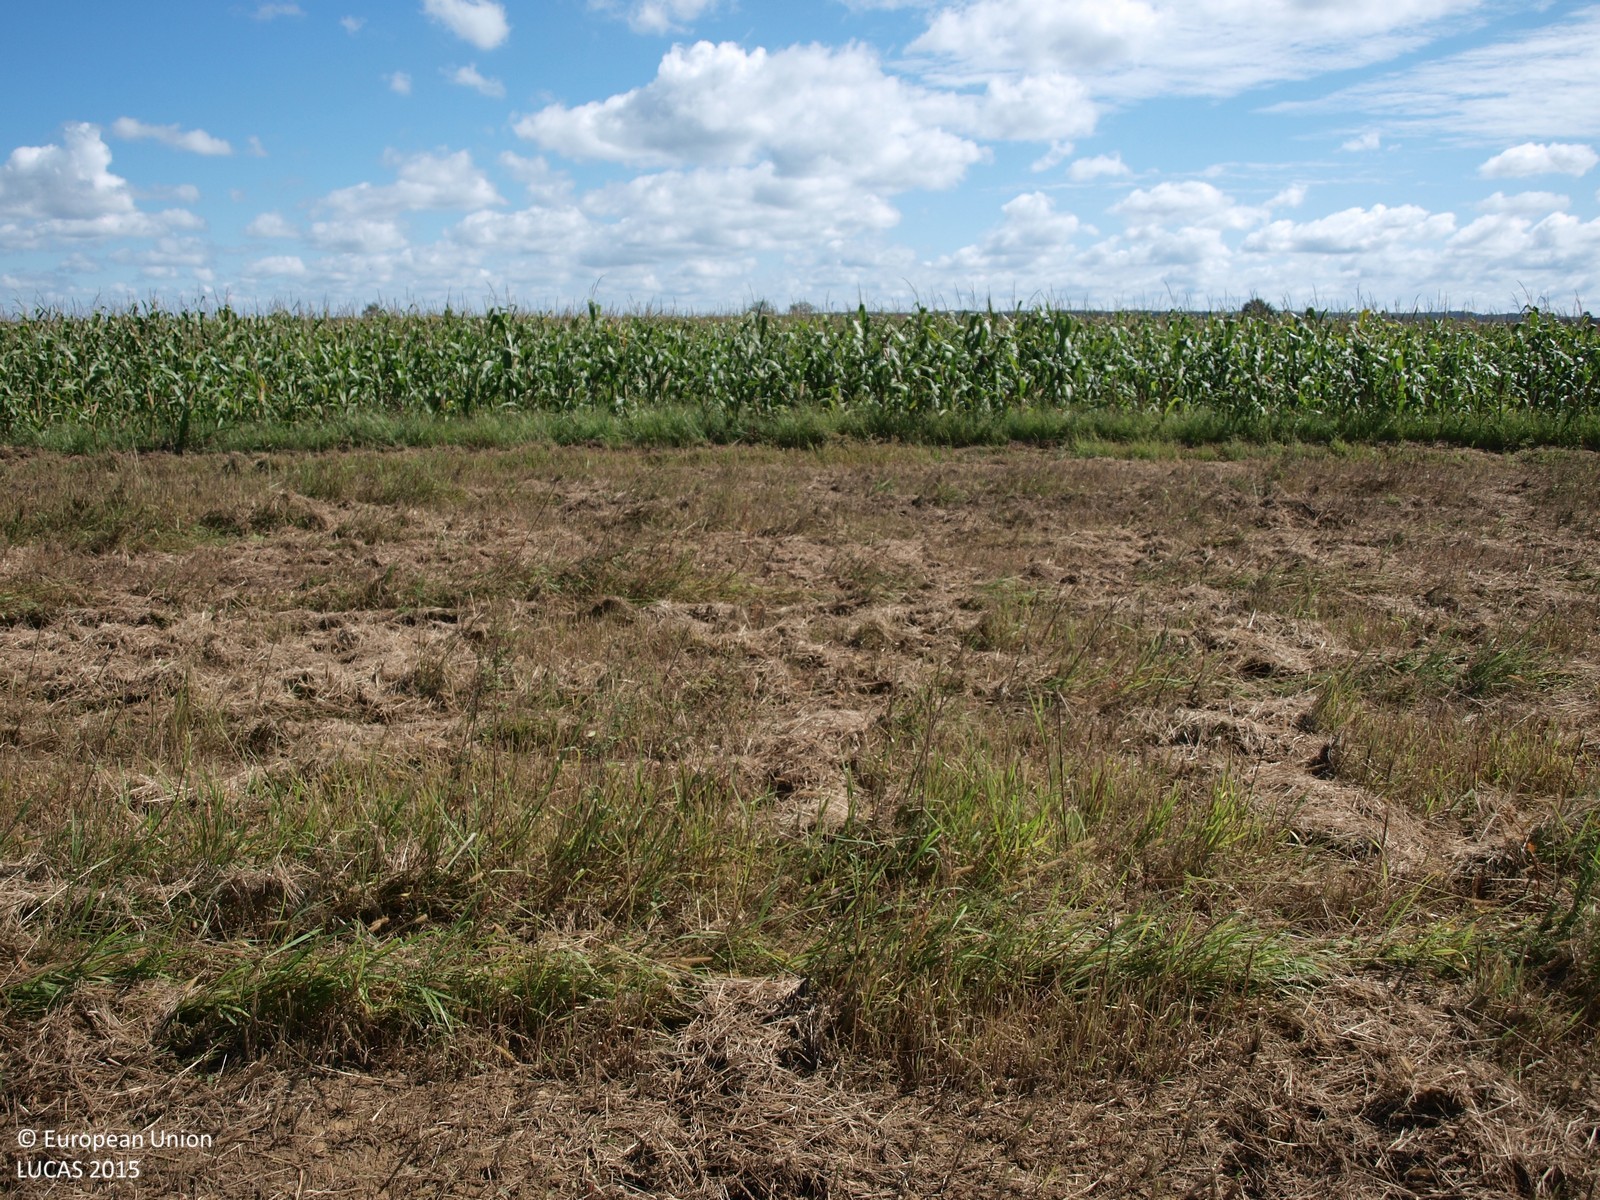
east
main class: Grassland
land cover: Grassland without tree/shrub cover
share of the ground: > 75 %
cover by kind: herbaceous plants 100 %
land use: Agriculture (excluding fallow land and kitchen gardens)
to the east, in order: Grassland without tree/shrub cover; Maize; Grassland without tree/shrub cover; Maize; Grassland without tree/shrub cover; Maize
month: September
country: HR
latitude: 45.7791
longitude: 16.4166
